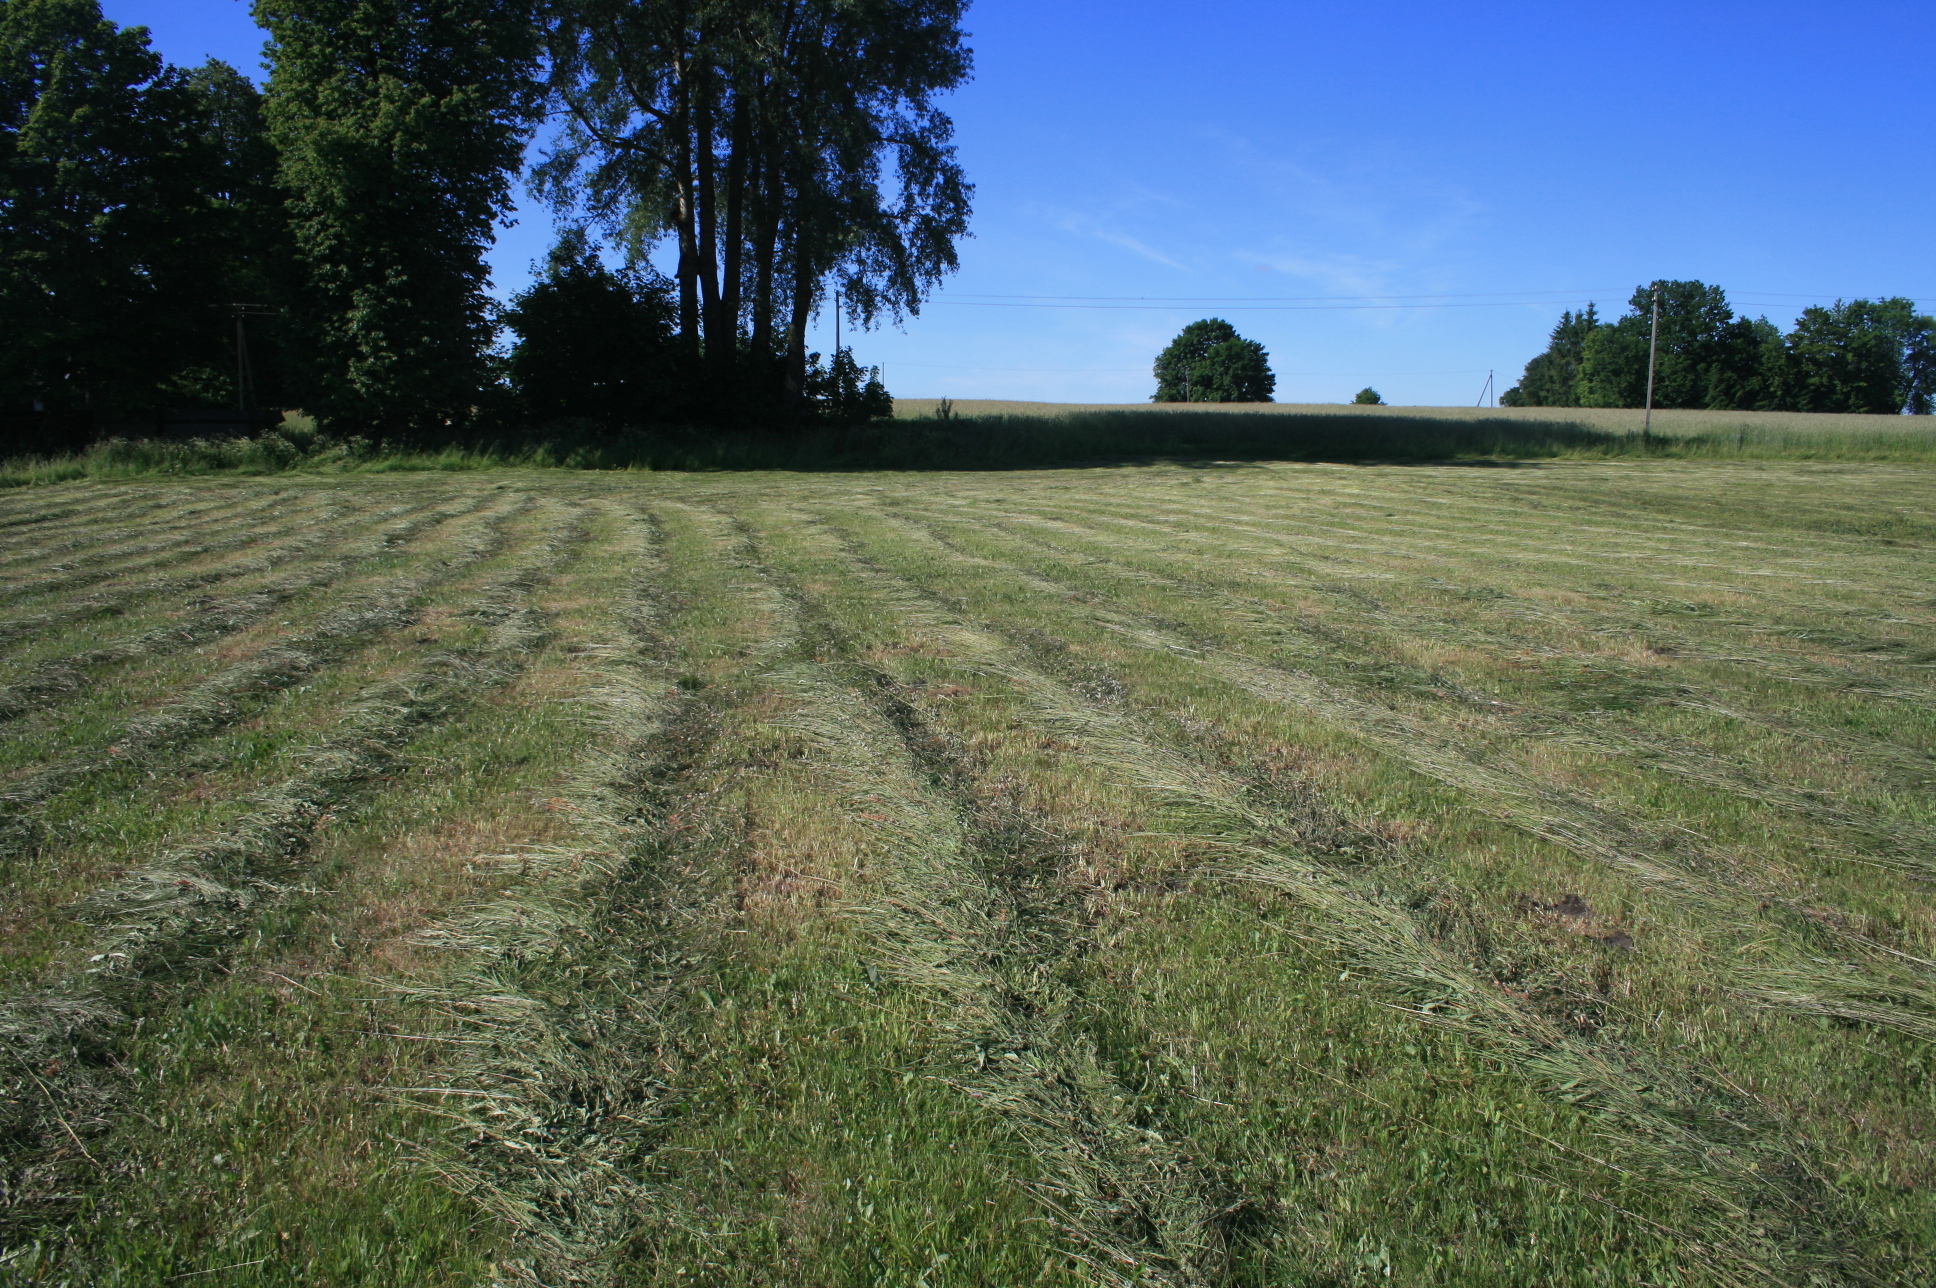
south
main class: Grassland
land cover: Grassland without tree/shrub cover
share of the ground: > 75 %
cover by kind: herbaceous plants 100 %
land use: Agriculture (excluding fallow land and kitchen gardens)
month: June
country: LT
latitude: 55.4648
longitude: 22.1231
